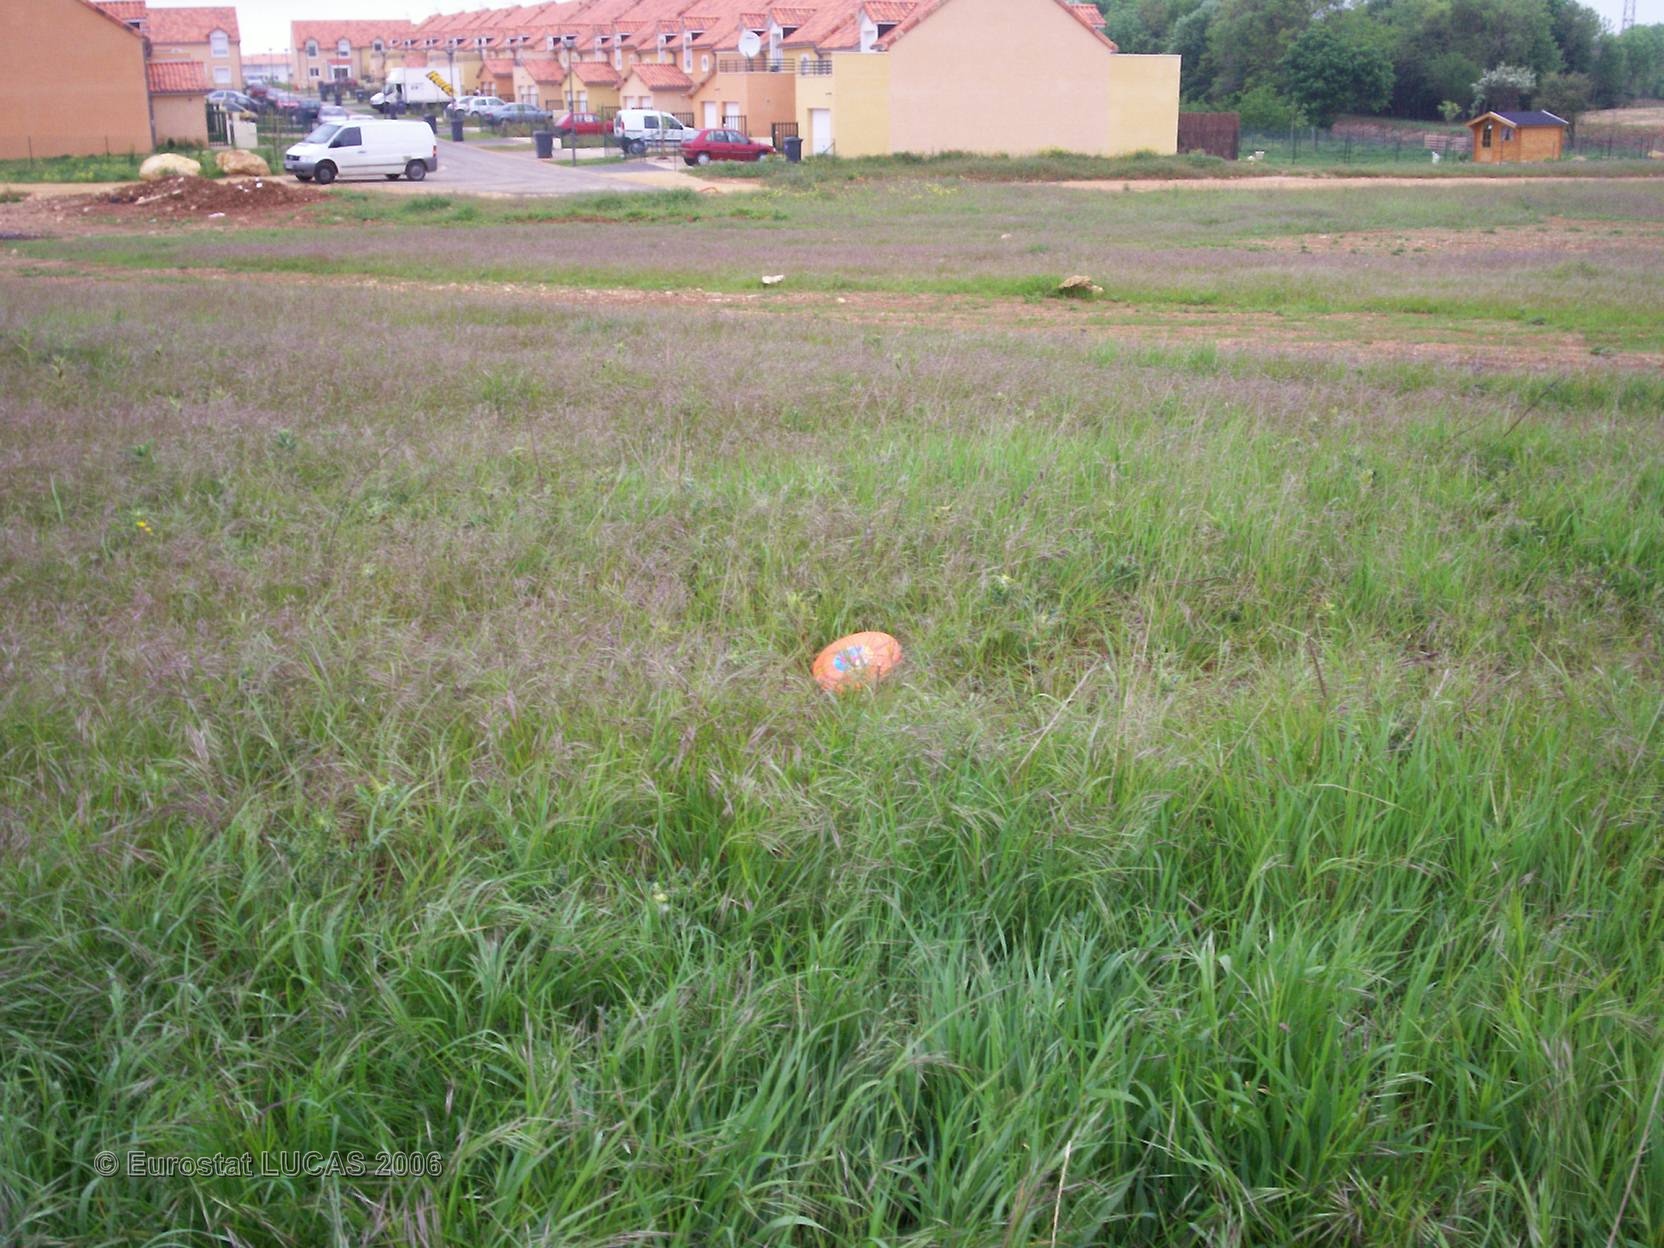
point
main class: Grassland
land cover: Grassland without tree/shrub cover
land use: Agriculture (excluding fallow land and kitchen gardens)
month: May
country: FR
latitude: 46.5883
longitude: 0.3885
